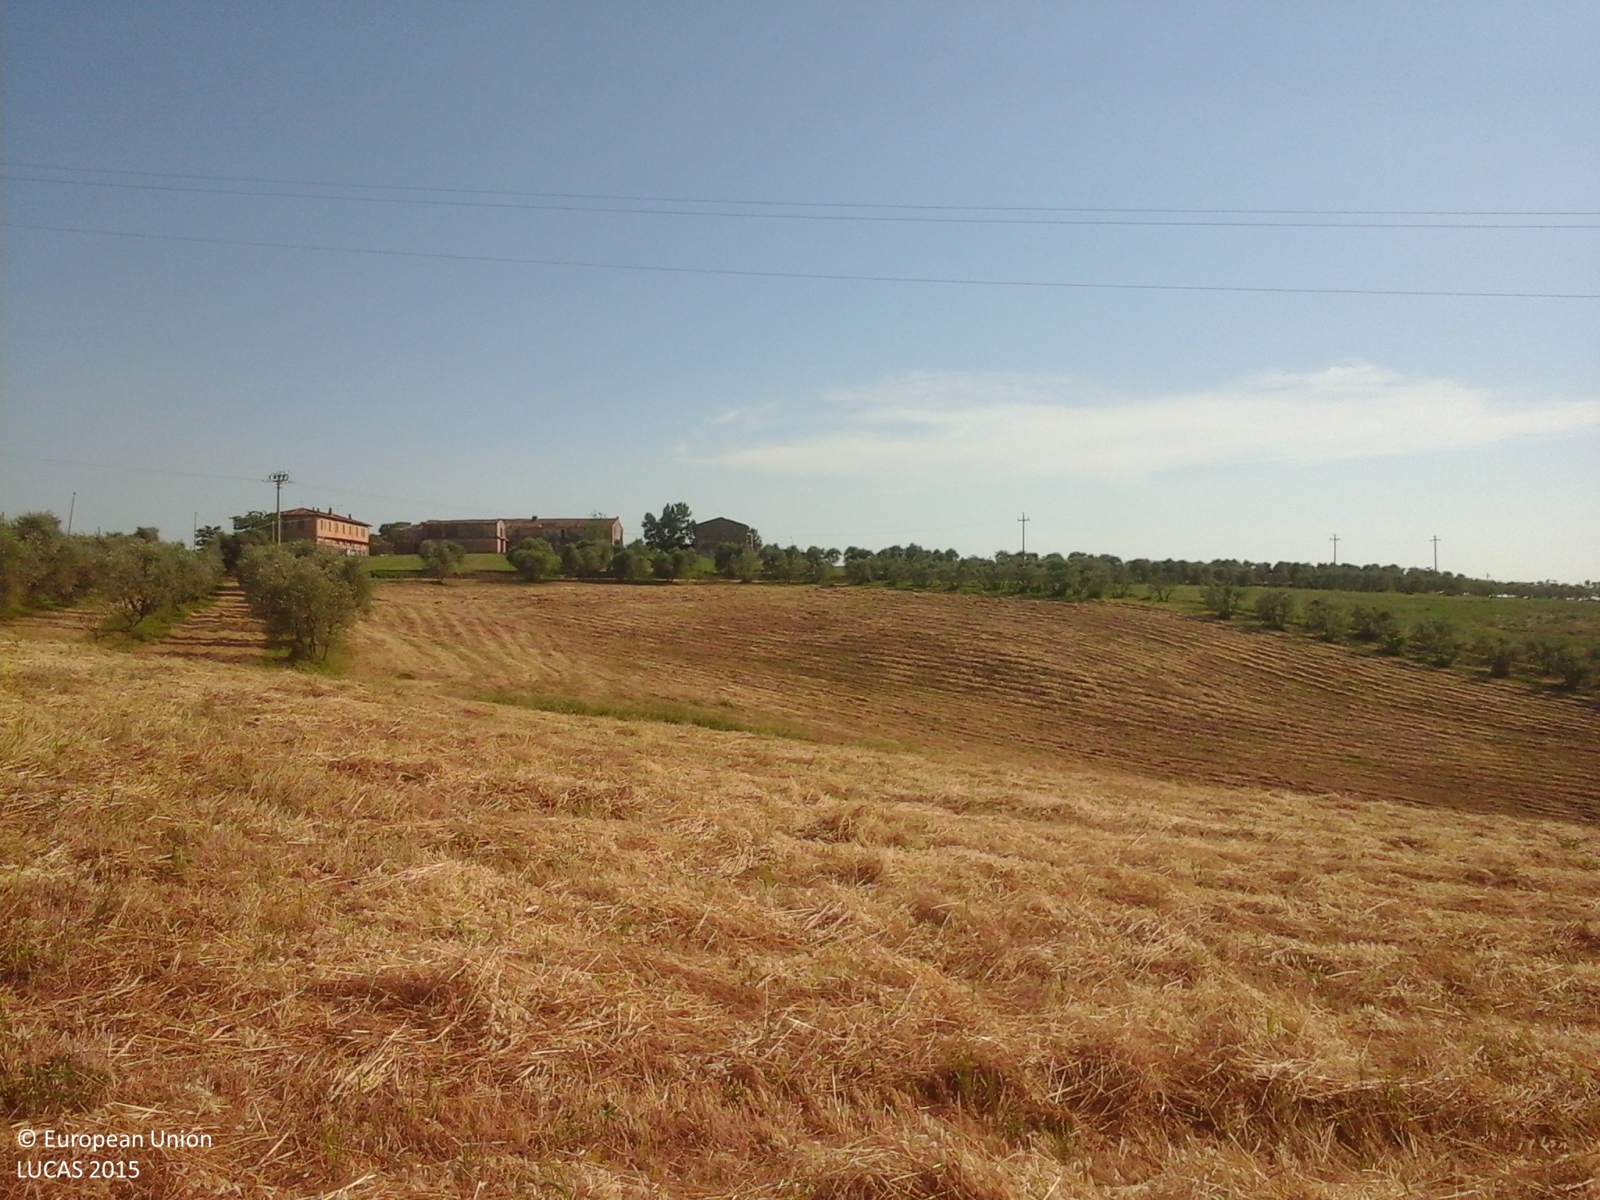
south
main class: Cropland
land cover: Mixed cereals for fodder
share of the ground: > 75 %
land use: Agriculture (excluding fallow land and kitchen gardens)
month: June
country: IT
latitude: 43.7691
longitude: 10.9293
